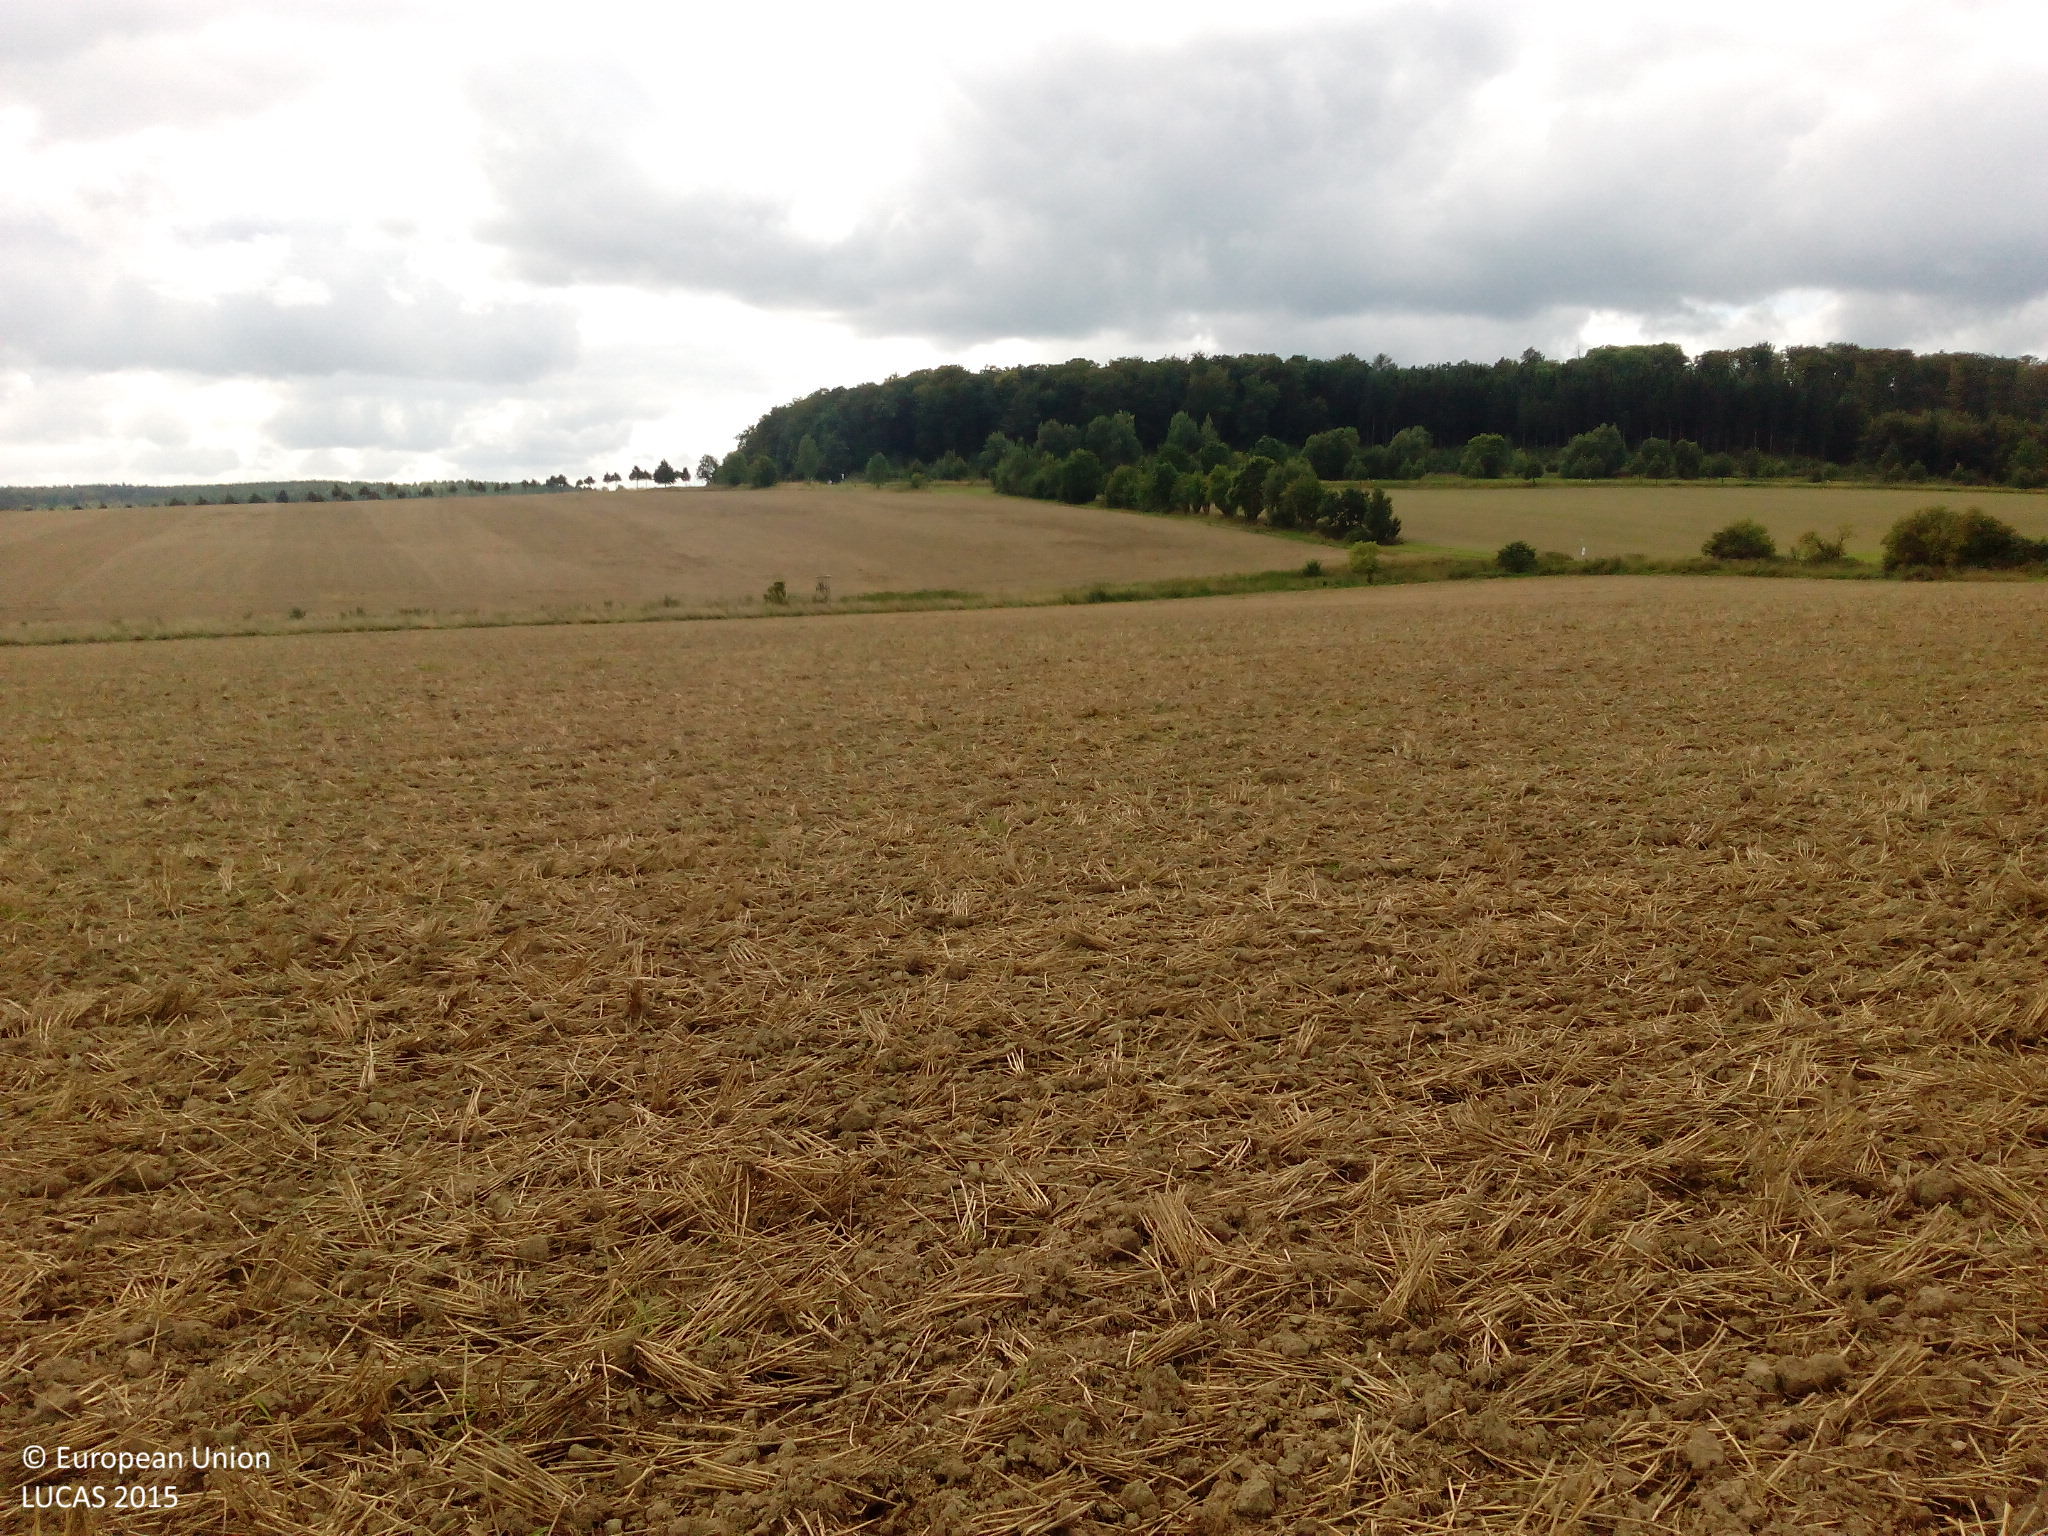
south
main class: Cropland
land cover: Common wheat
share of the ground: < 10 %
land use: Agriculture (excluding fallow land and kitchen gardens)
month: September
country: DE
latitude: 51.6540
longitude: 11.0260
